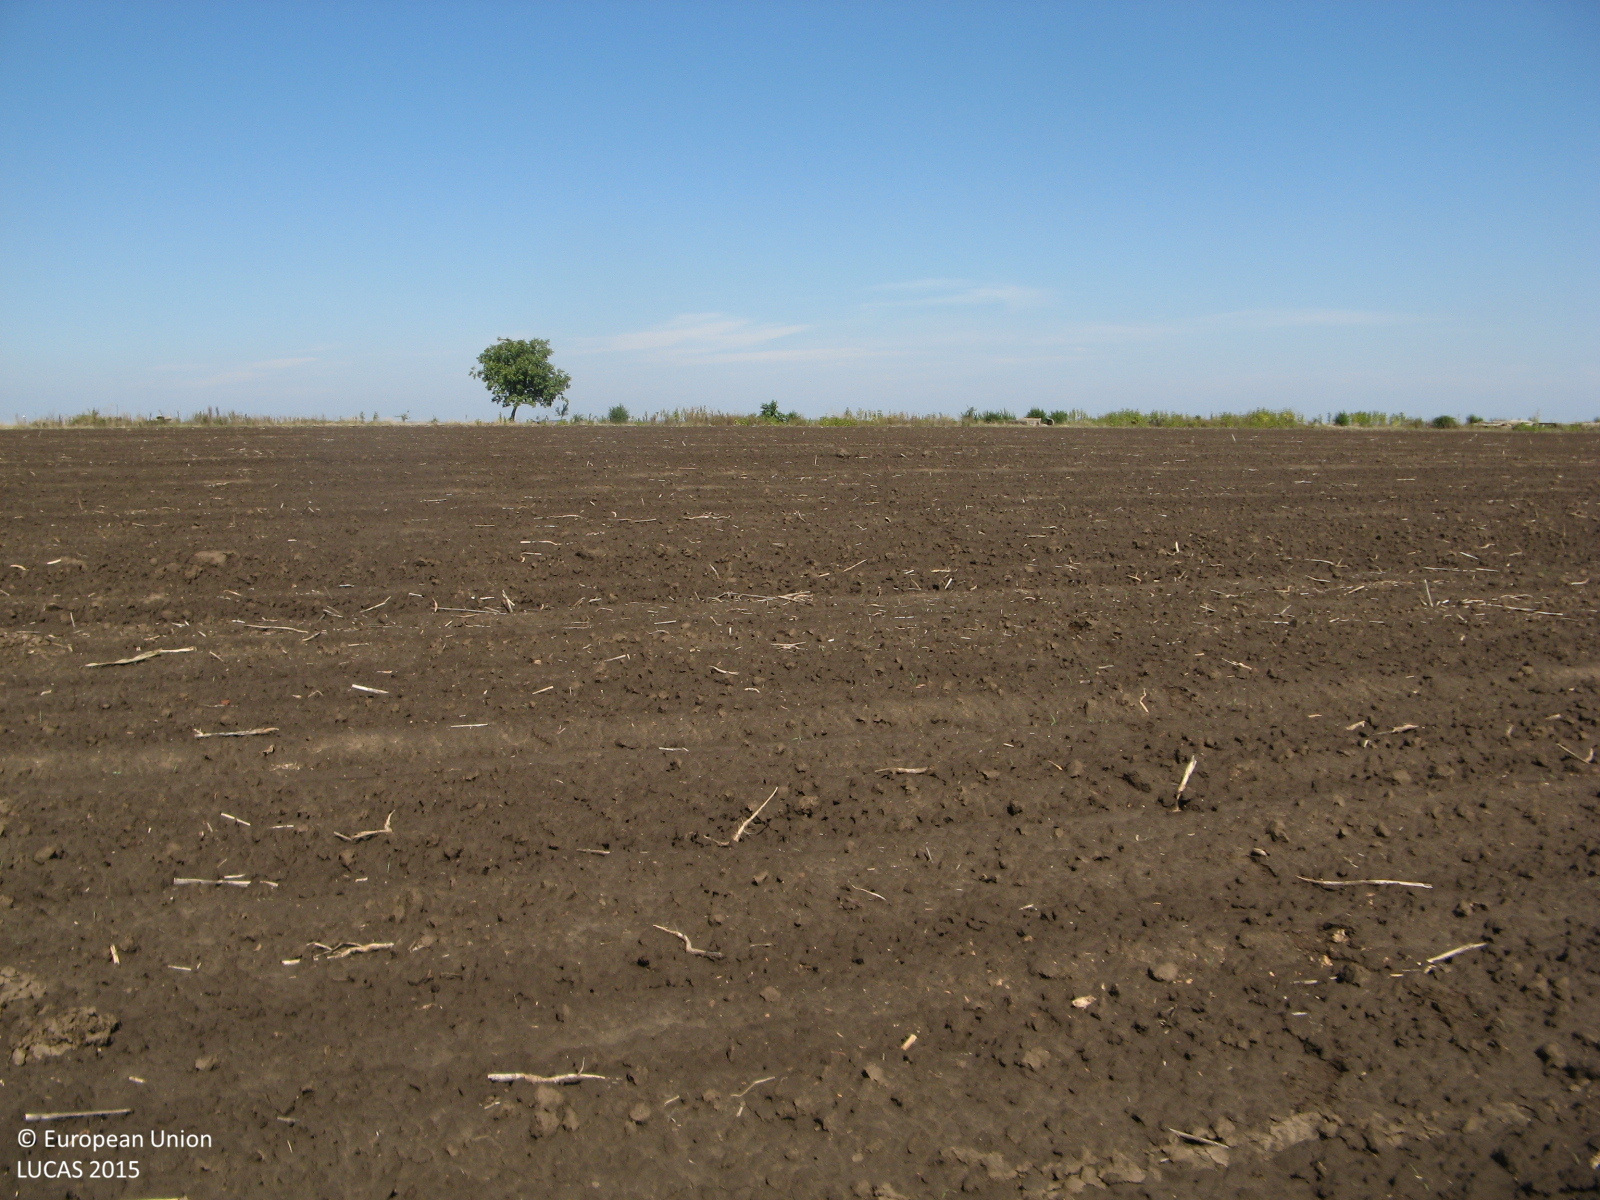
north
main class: Cropland
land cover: Rape and turnip rape
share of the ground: < 10 %
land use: Agriculture (excluding fallow land and kitchen gardens)
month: September
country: BG
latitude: 43.4899
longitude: 25.3748
